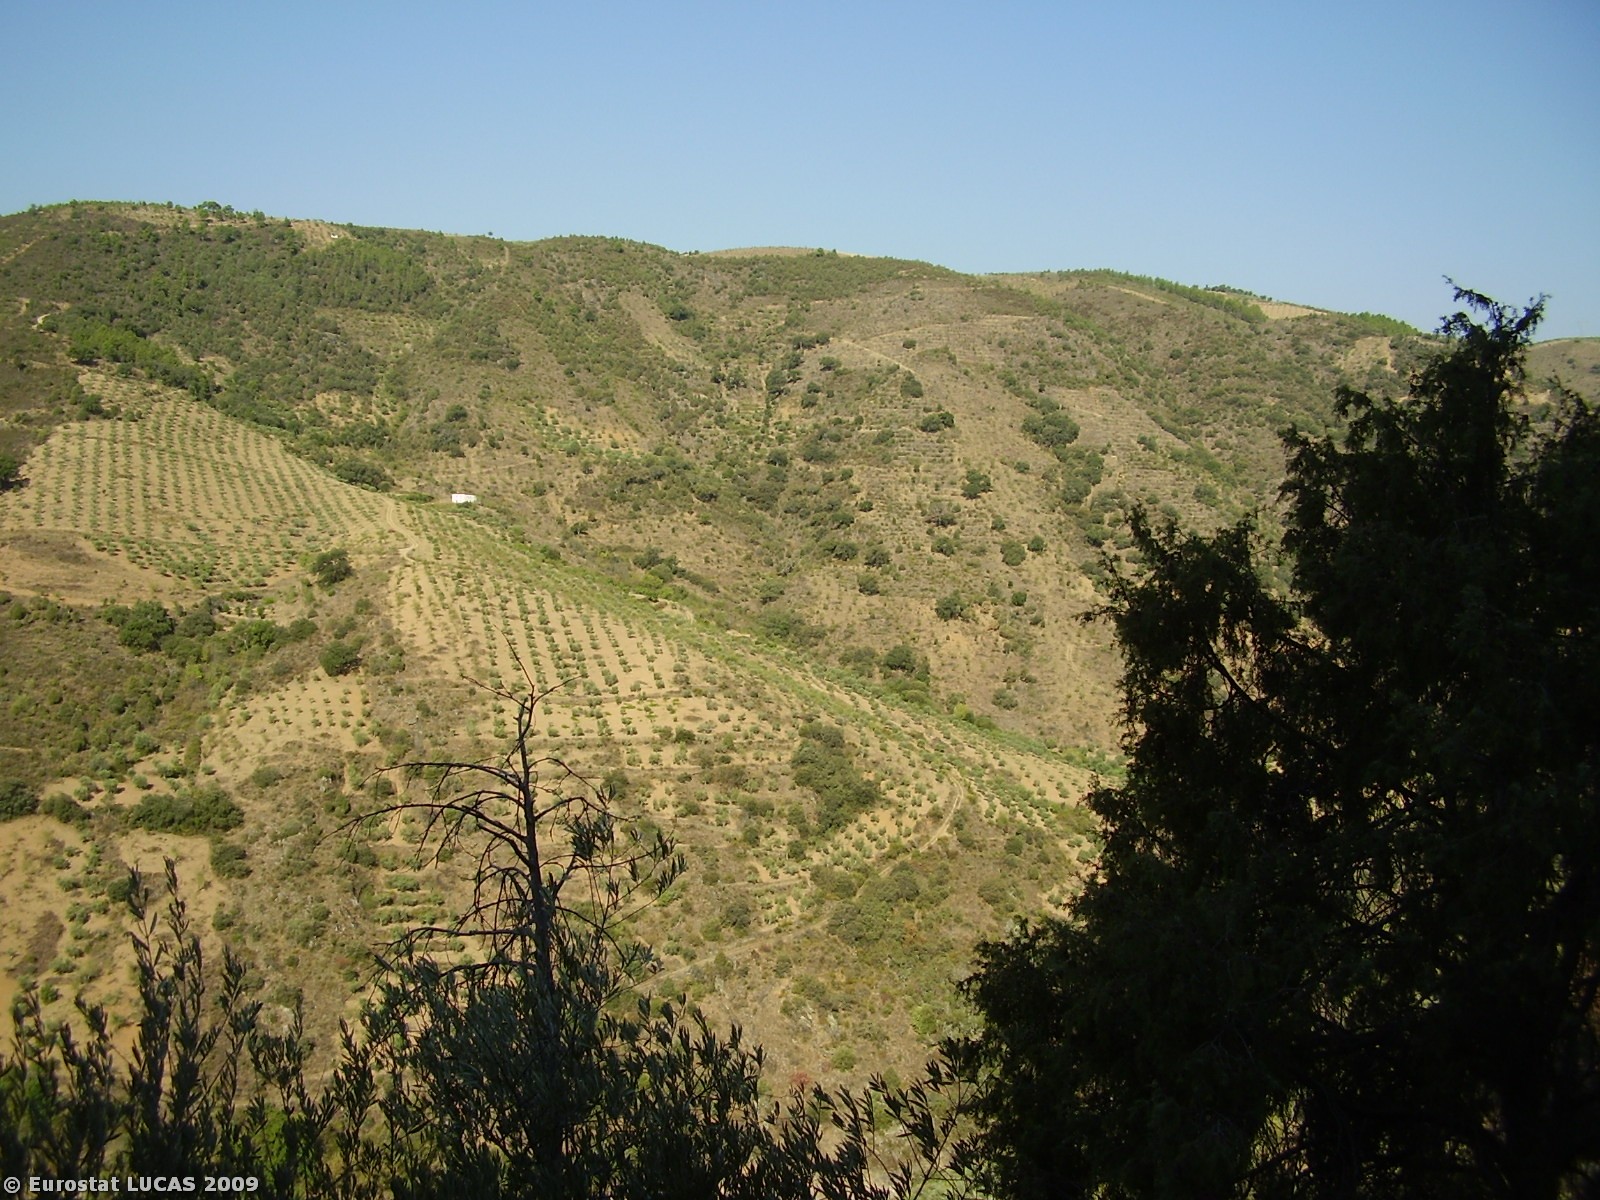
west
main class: Shrubland
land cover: Shrubland with sparse tree cover
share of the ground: > 75 %
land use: Fallow land
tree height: > 5 m
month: August
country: PT
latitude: 41.3271
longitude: -6.8226
